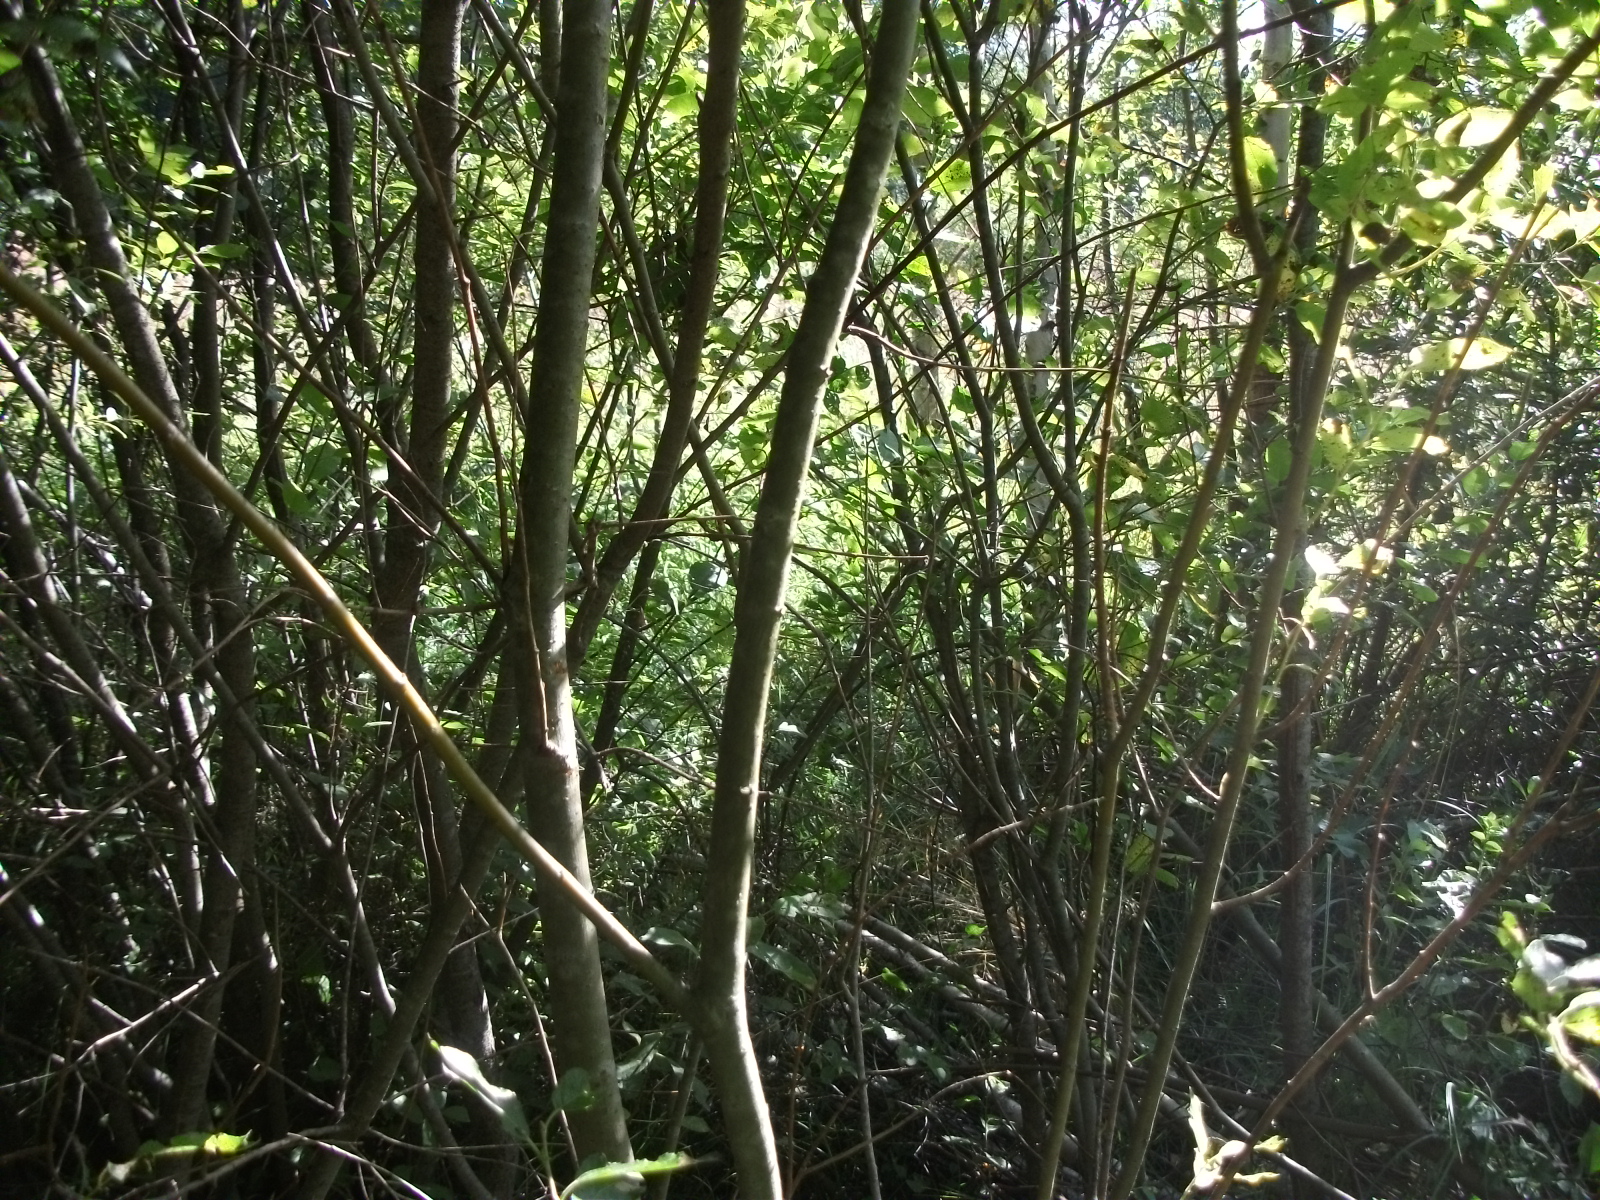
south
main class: Woodland
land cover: Broadleaved woodland
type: non-riverine alder, birch or aspen forest
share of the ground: 50 - 75 %
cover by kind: broadleaved forest trees 50 %, shrubs 45 %, herbaceous plants 5 %
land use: Semi-natural and natural areas not in use
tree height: < 5 m
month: August
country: LV
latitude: 56.5411
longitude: 26.0898
